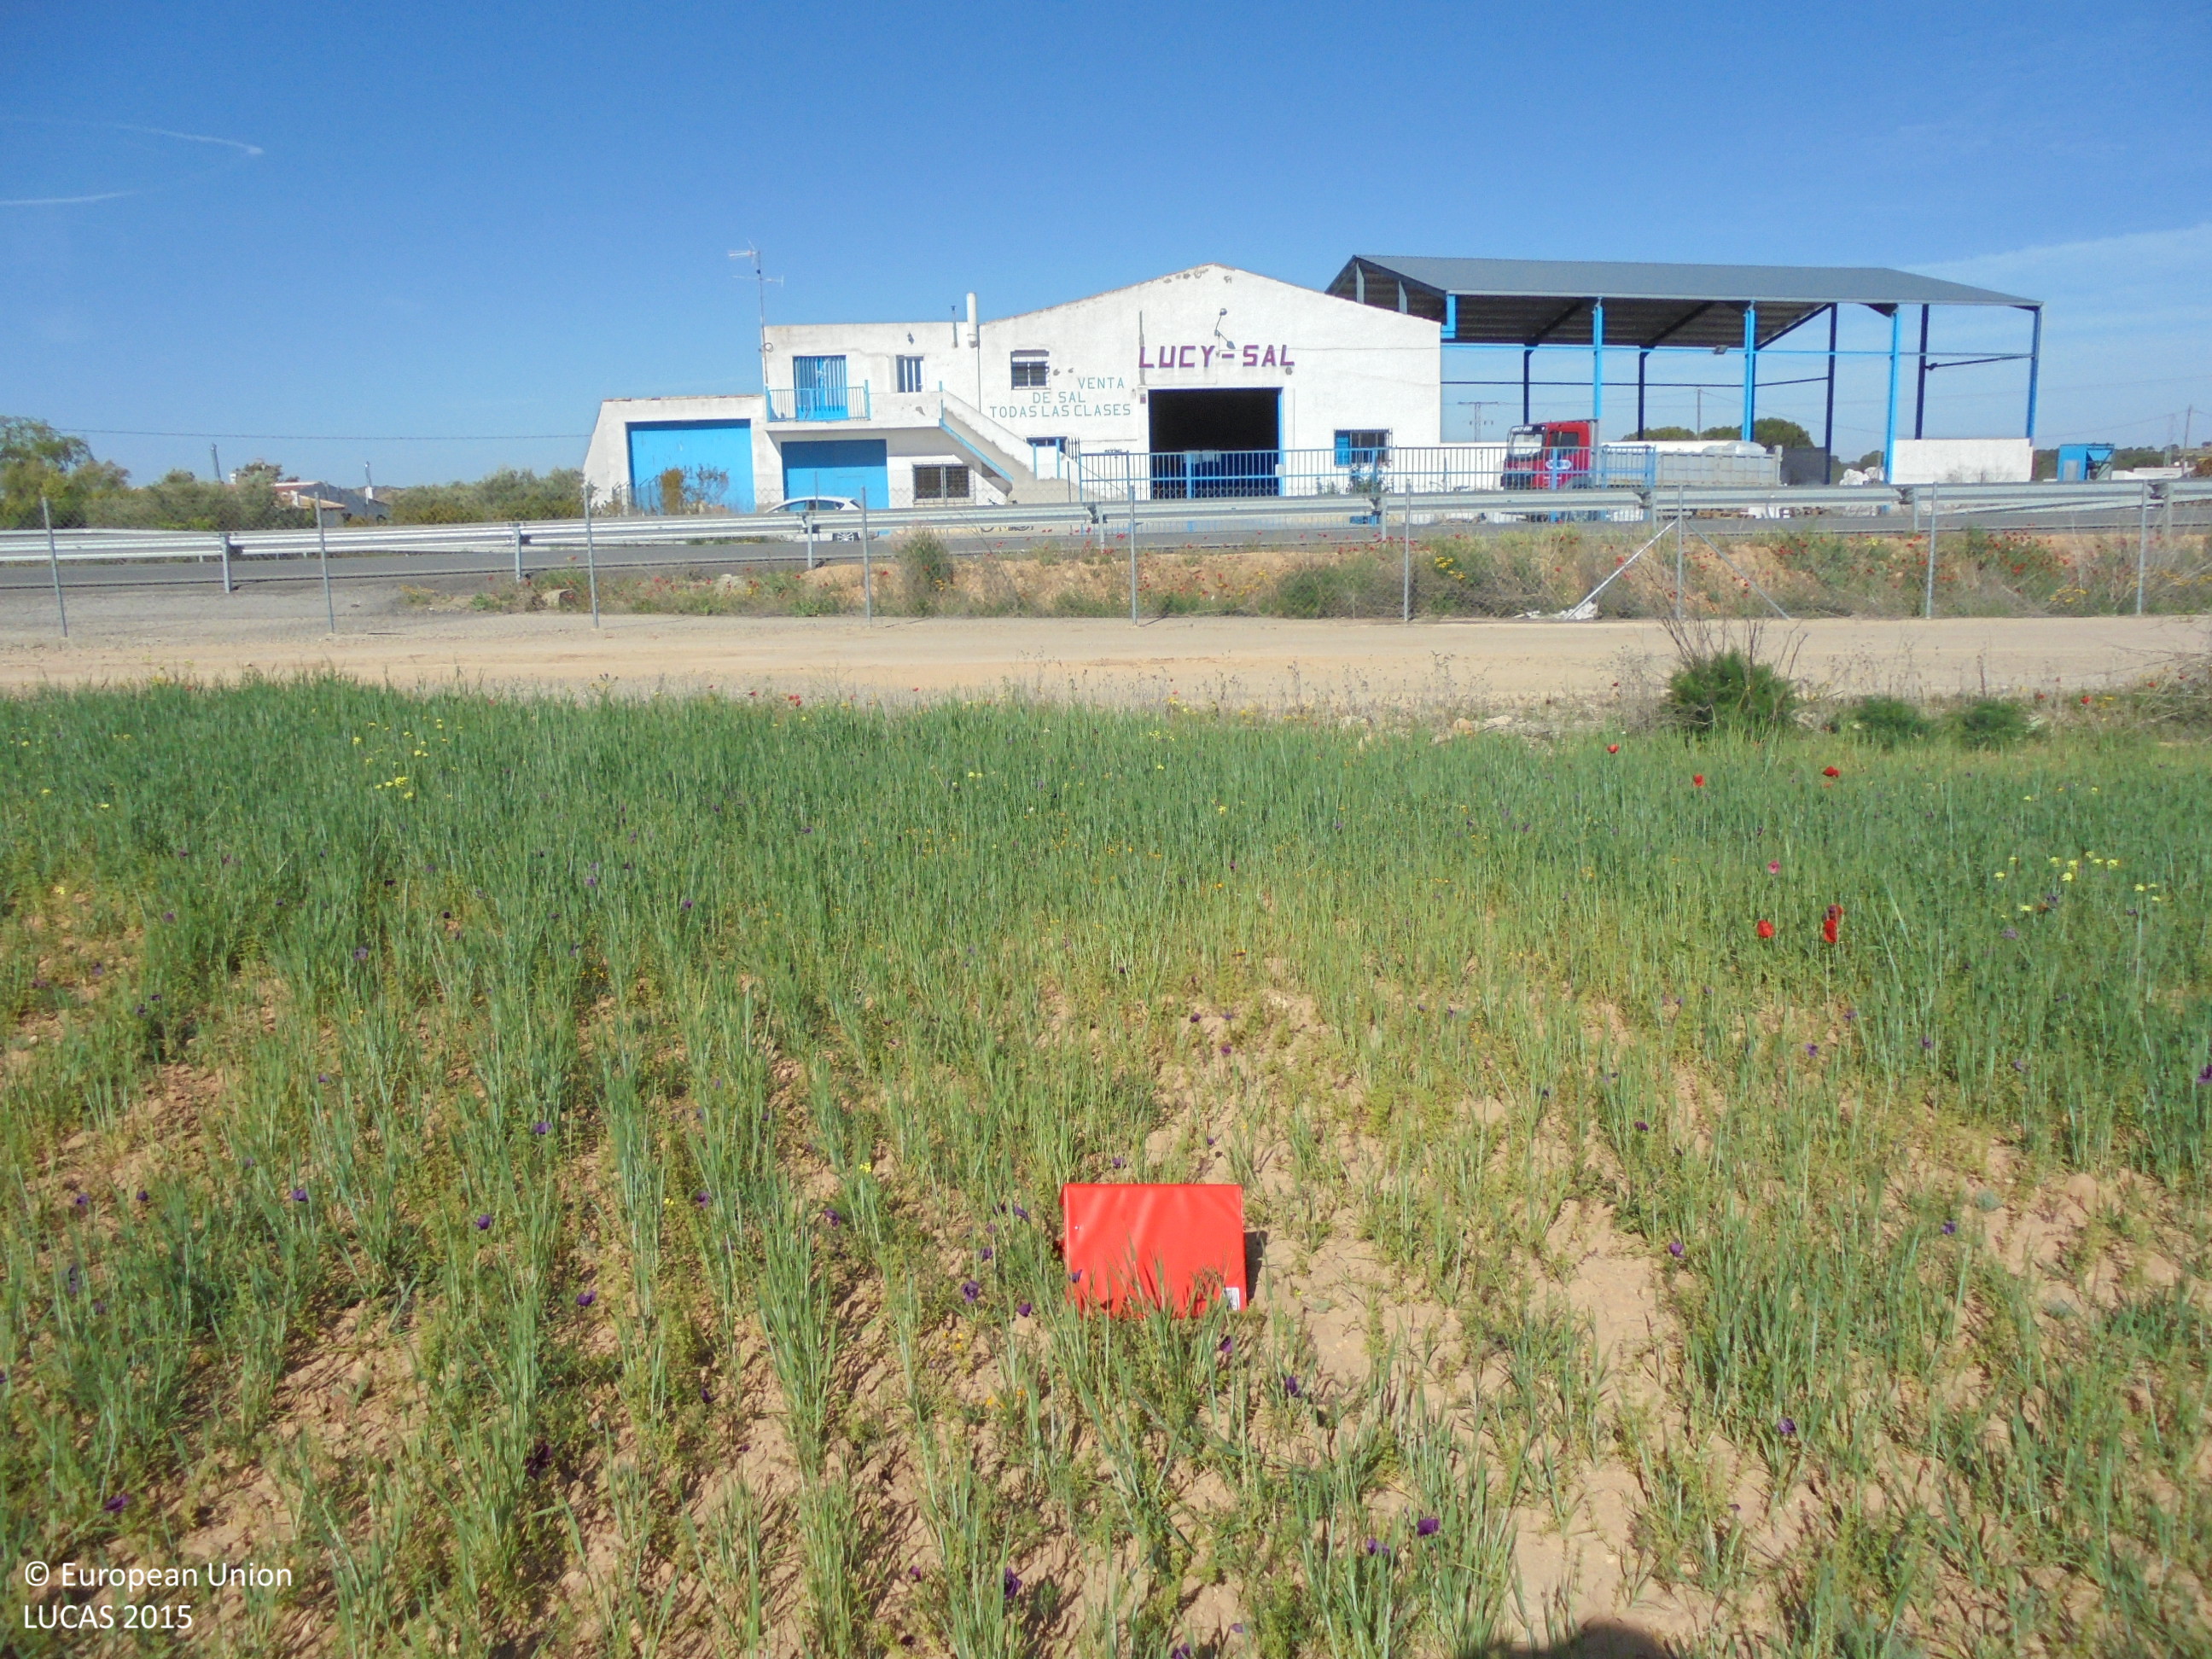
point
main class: Cropland
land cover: Barley
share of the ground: 25 - 50 %
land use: Agriculture (excluding fallow land and kitchen gardens)
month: May
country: ES
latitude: 39.2713
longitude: -1.5580
